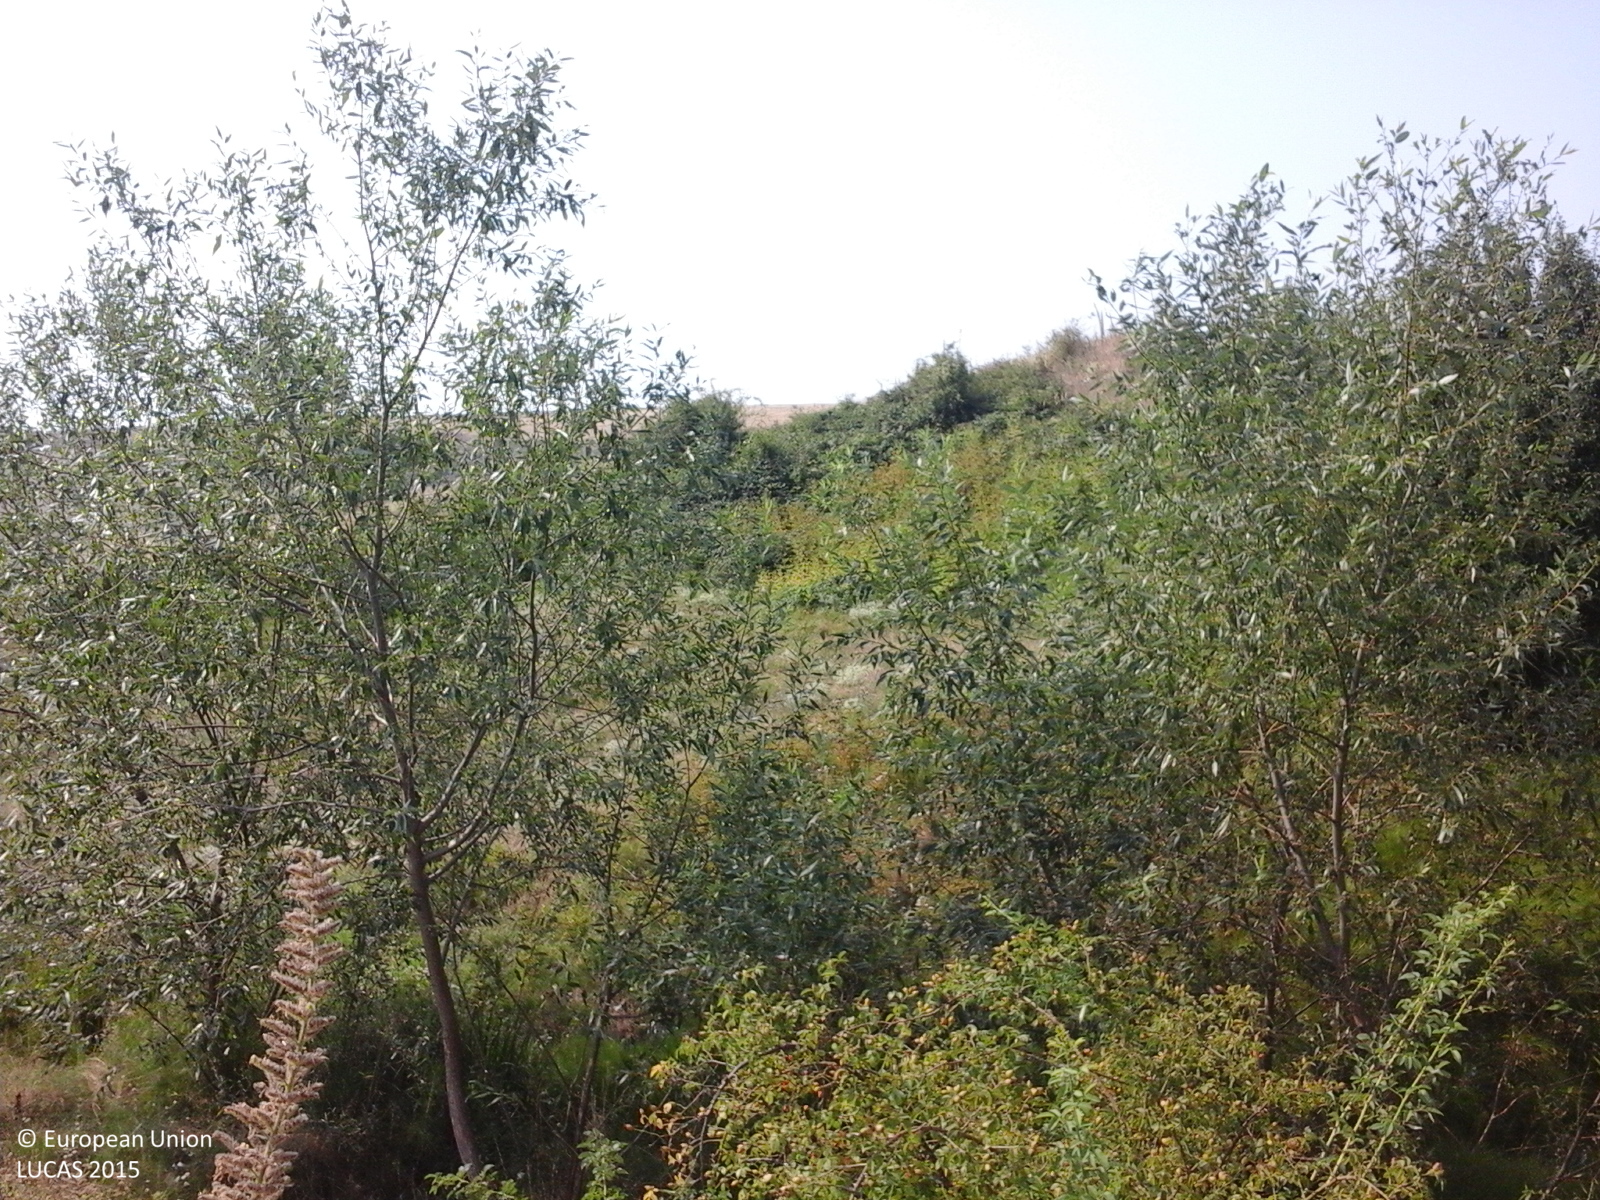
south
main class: Grassland
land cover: Spontaneously vegetated surfaces
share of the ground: > 75 %
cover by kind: herbaceous plants 100 %
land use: Agriculture (excluding fallow land and kitchen gardens)
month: August
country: RO
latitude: 44.5341
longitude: 22.8417
